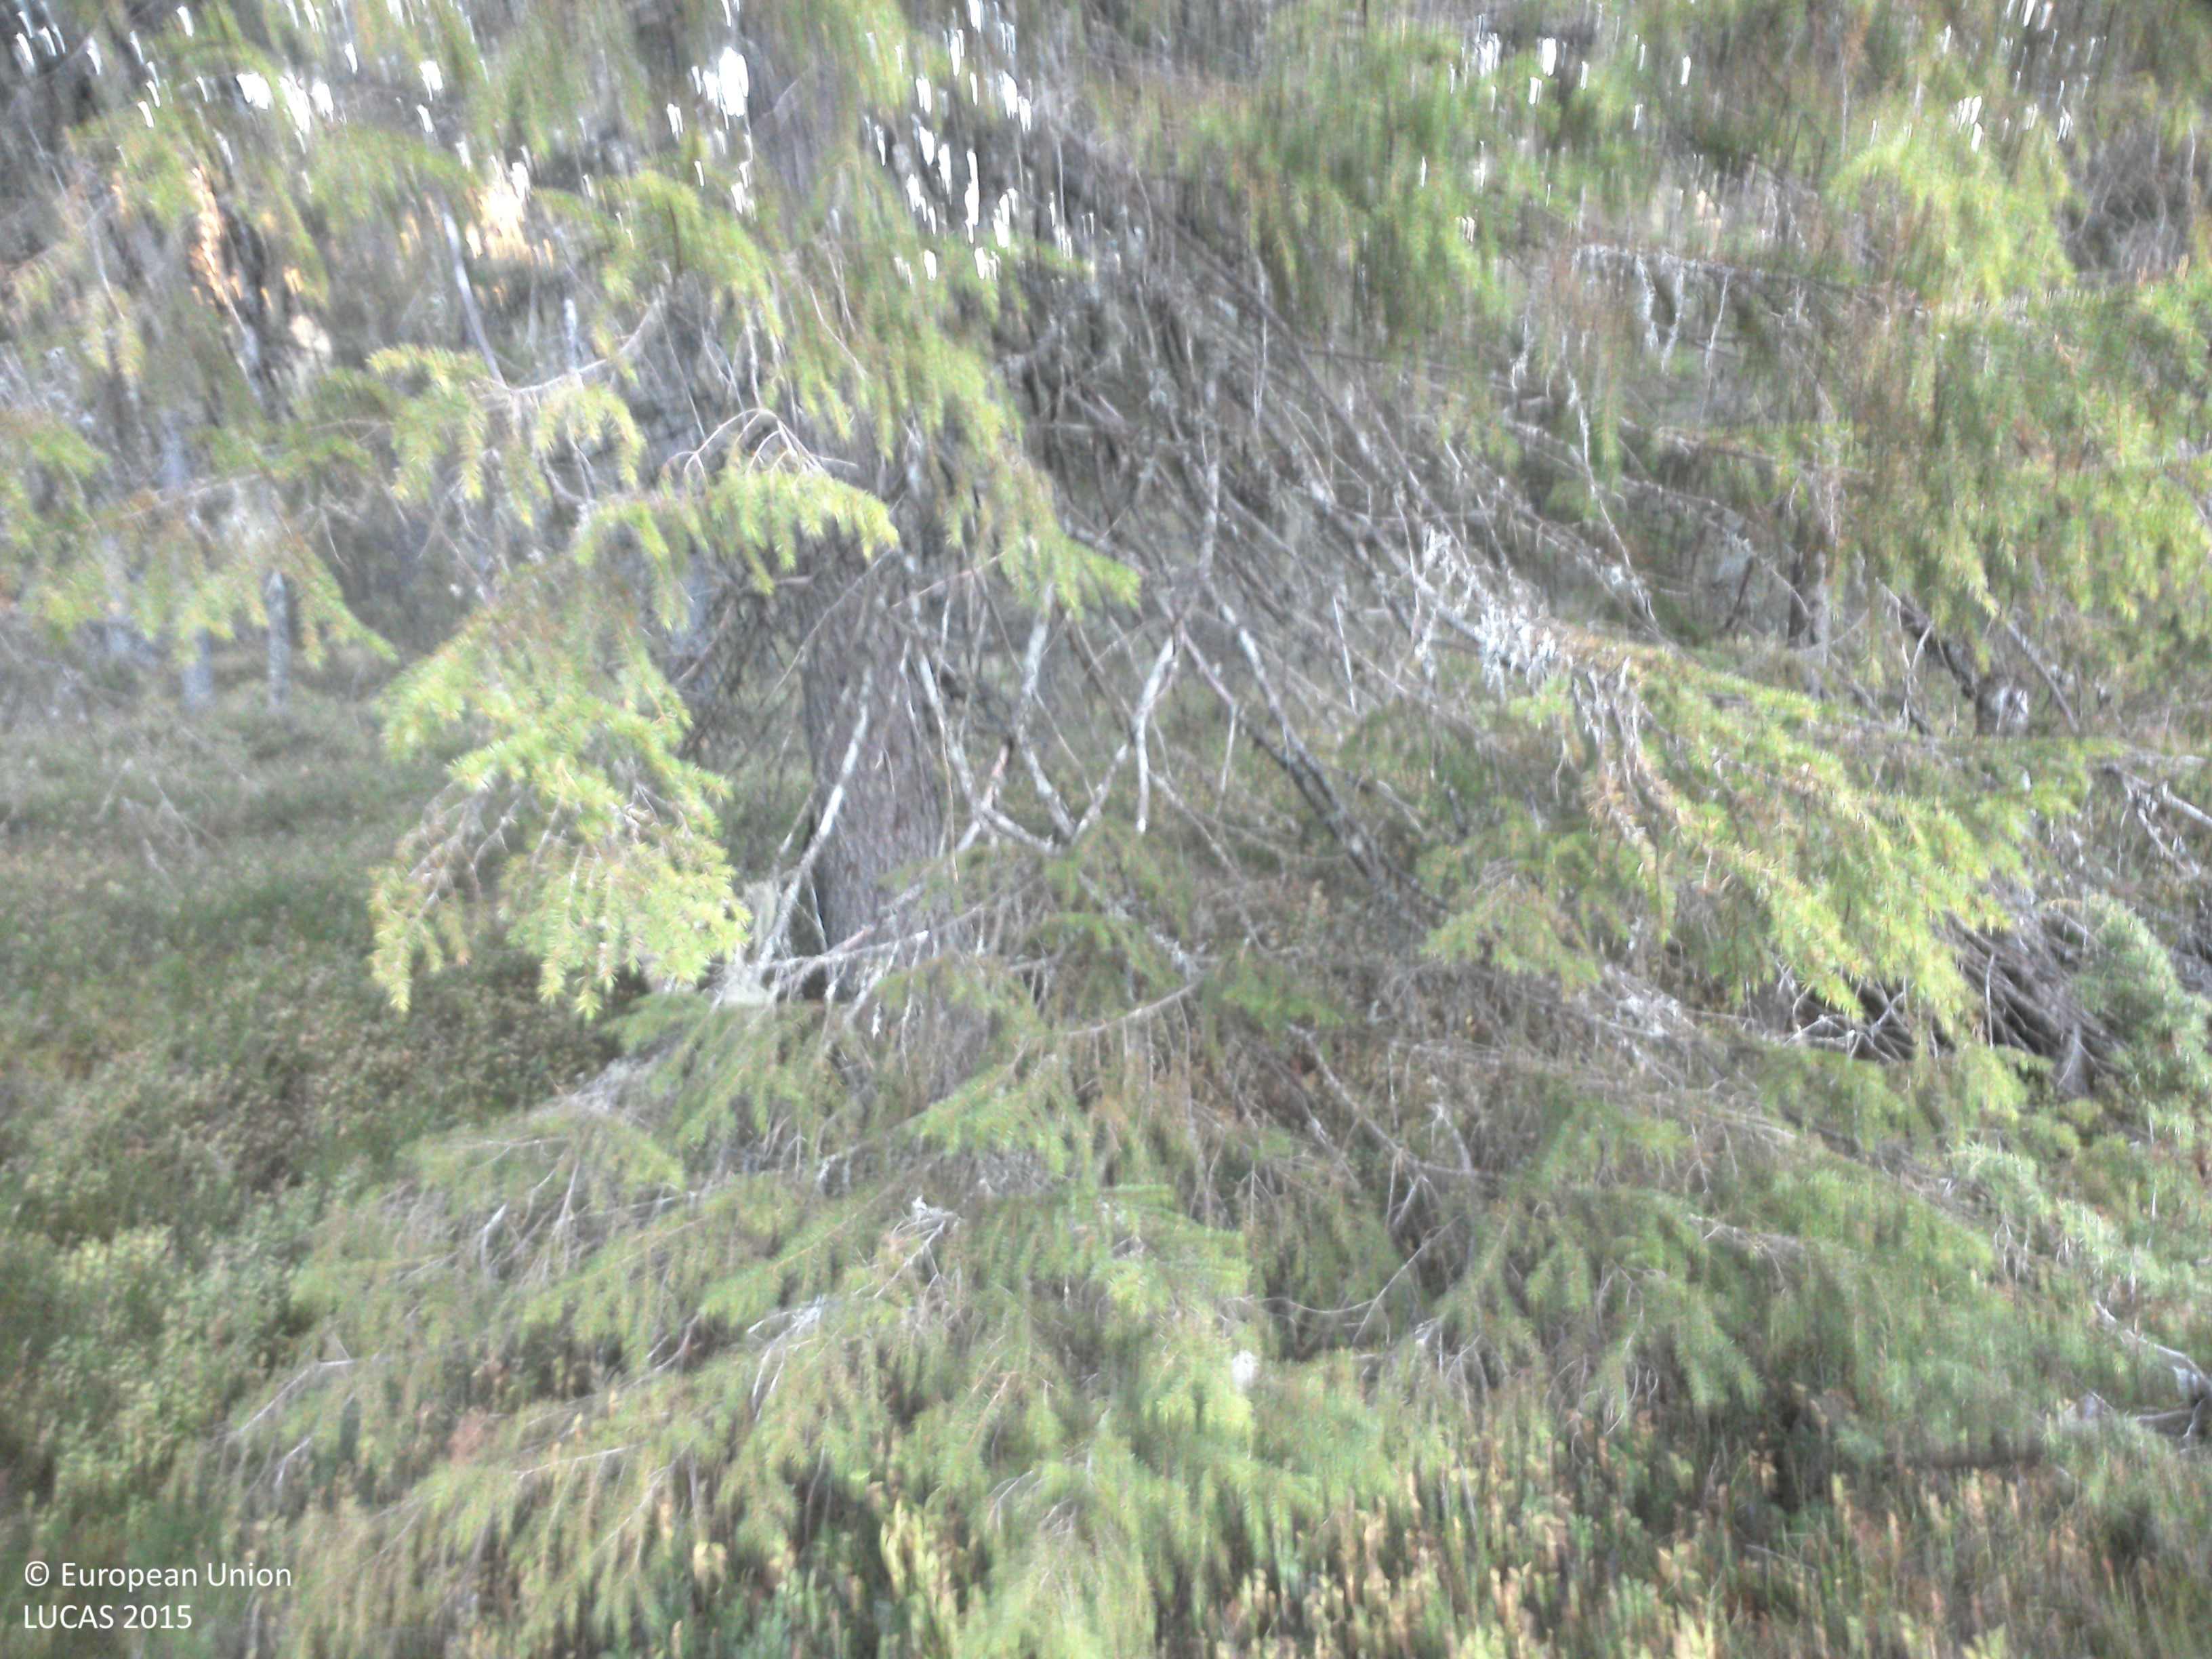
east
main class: Woodland
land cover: Spruce dominated coniferous woodland
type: boreal forest
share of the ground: 25 - 50 %
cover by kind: shrubs 60 %, coniferous forest trees 40 %
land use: Forestry
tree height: > 5 m
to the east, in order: Spruce dominated coniferous woodland; Ditches and canals; Pine dominated mixed woodland
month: October
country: SE
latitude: 63.8268
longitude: 19.7118
